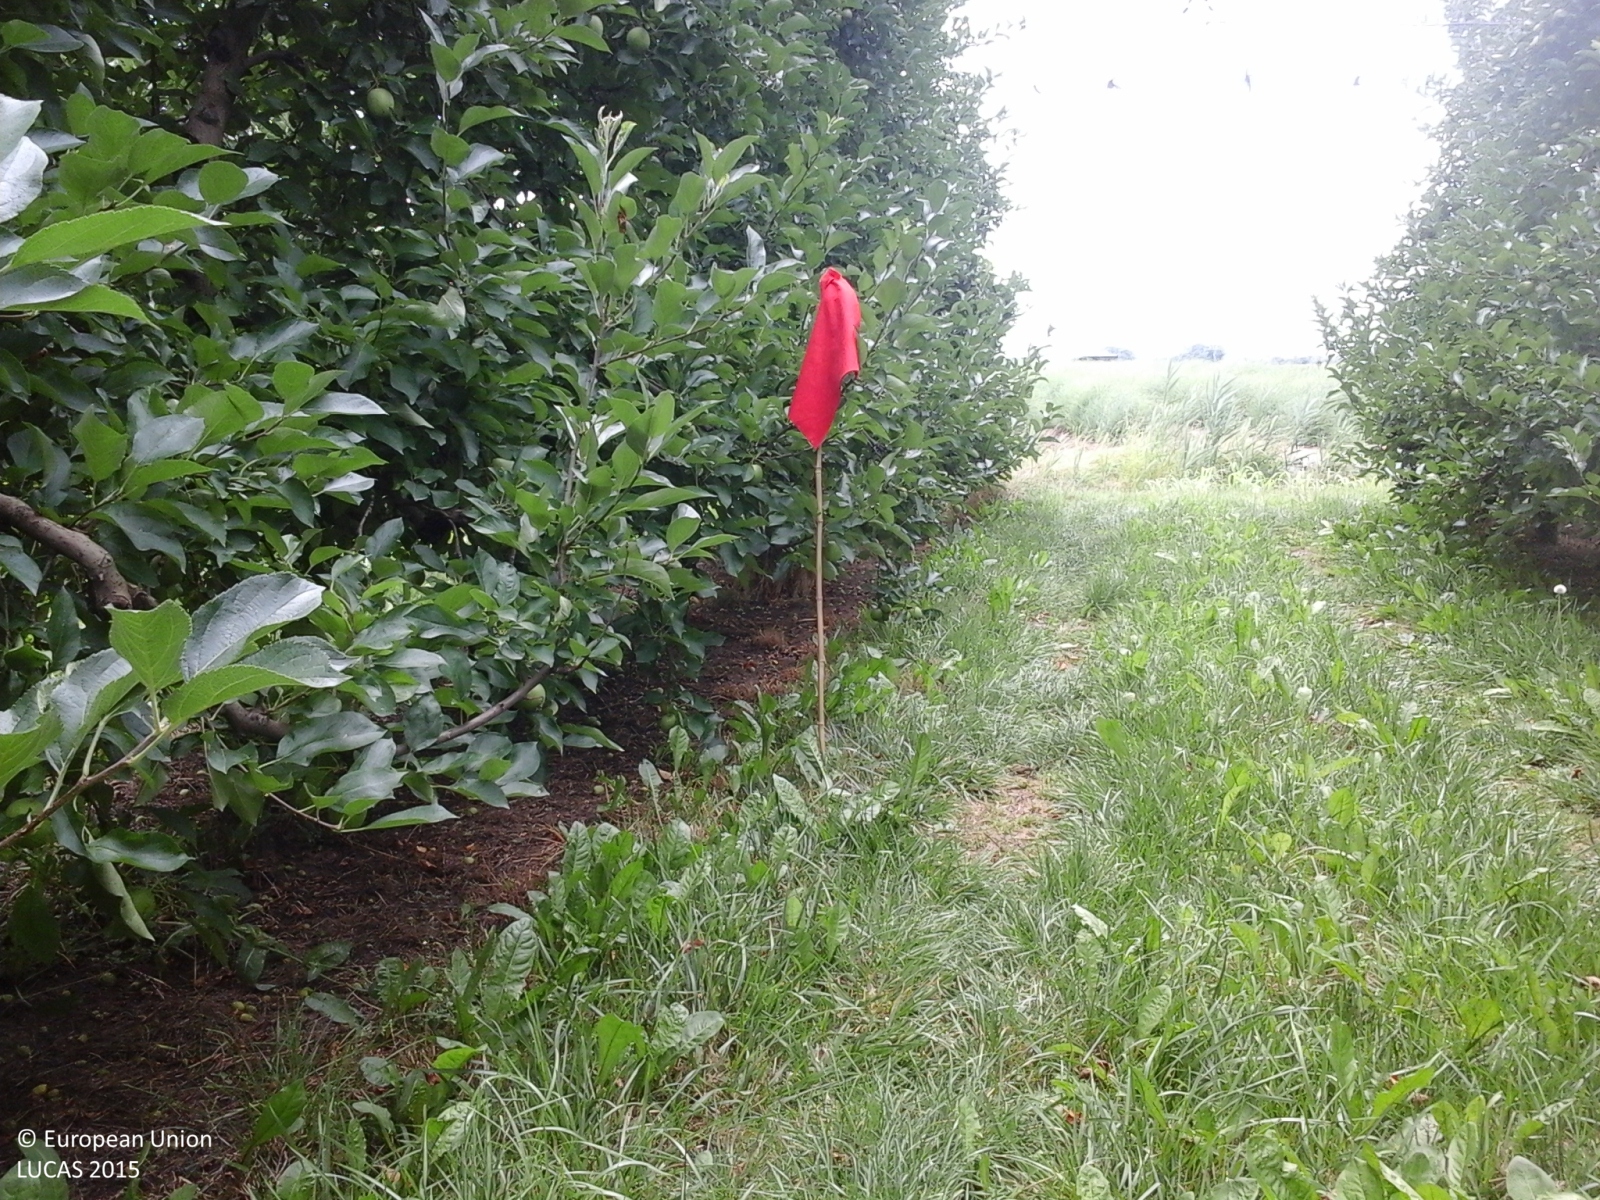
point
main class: Cropland
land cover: Apple fruit
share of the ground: 25 - 50 %
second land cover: Grassland without tree/shrub cover
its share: > 75 %
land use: Agriculture (excluding fallow land and kitchen gardens)
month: June
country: IT
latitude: 45.3896
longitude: 11.1858
